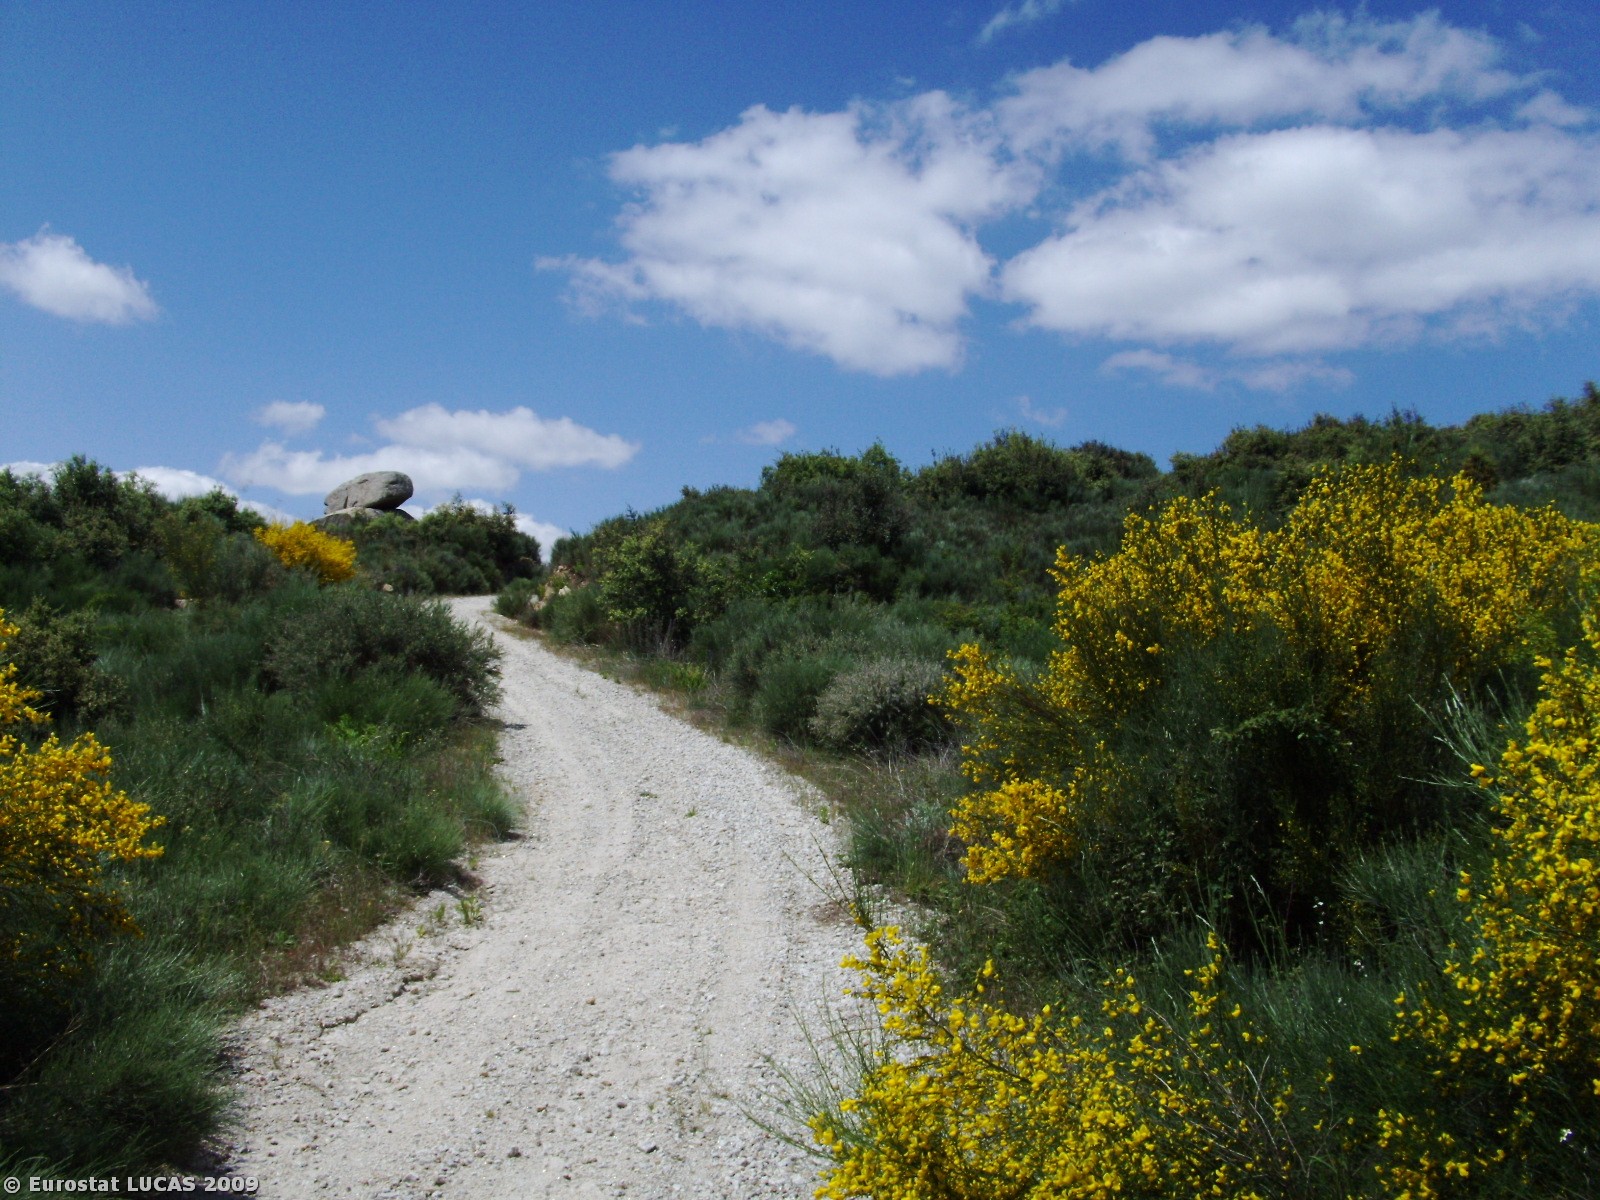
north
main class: Shrubland
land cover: Shrubland with sparse tree cover
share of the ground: > 75 %
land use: Unused
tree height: > 5 m
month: May
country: PT
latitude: 40.6244
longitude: -7.2603
